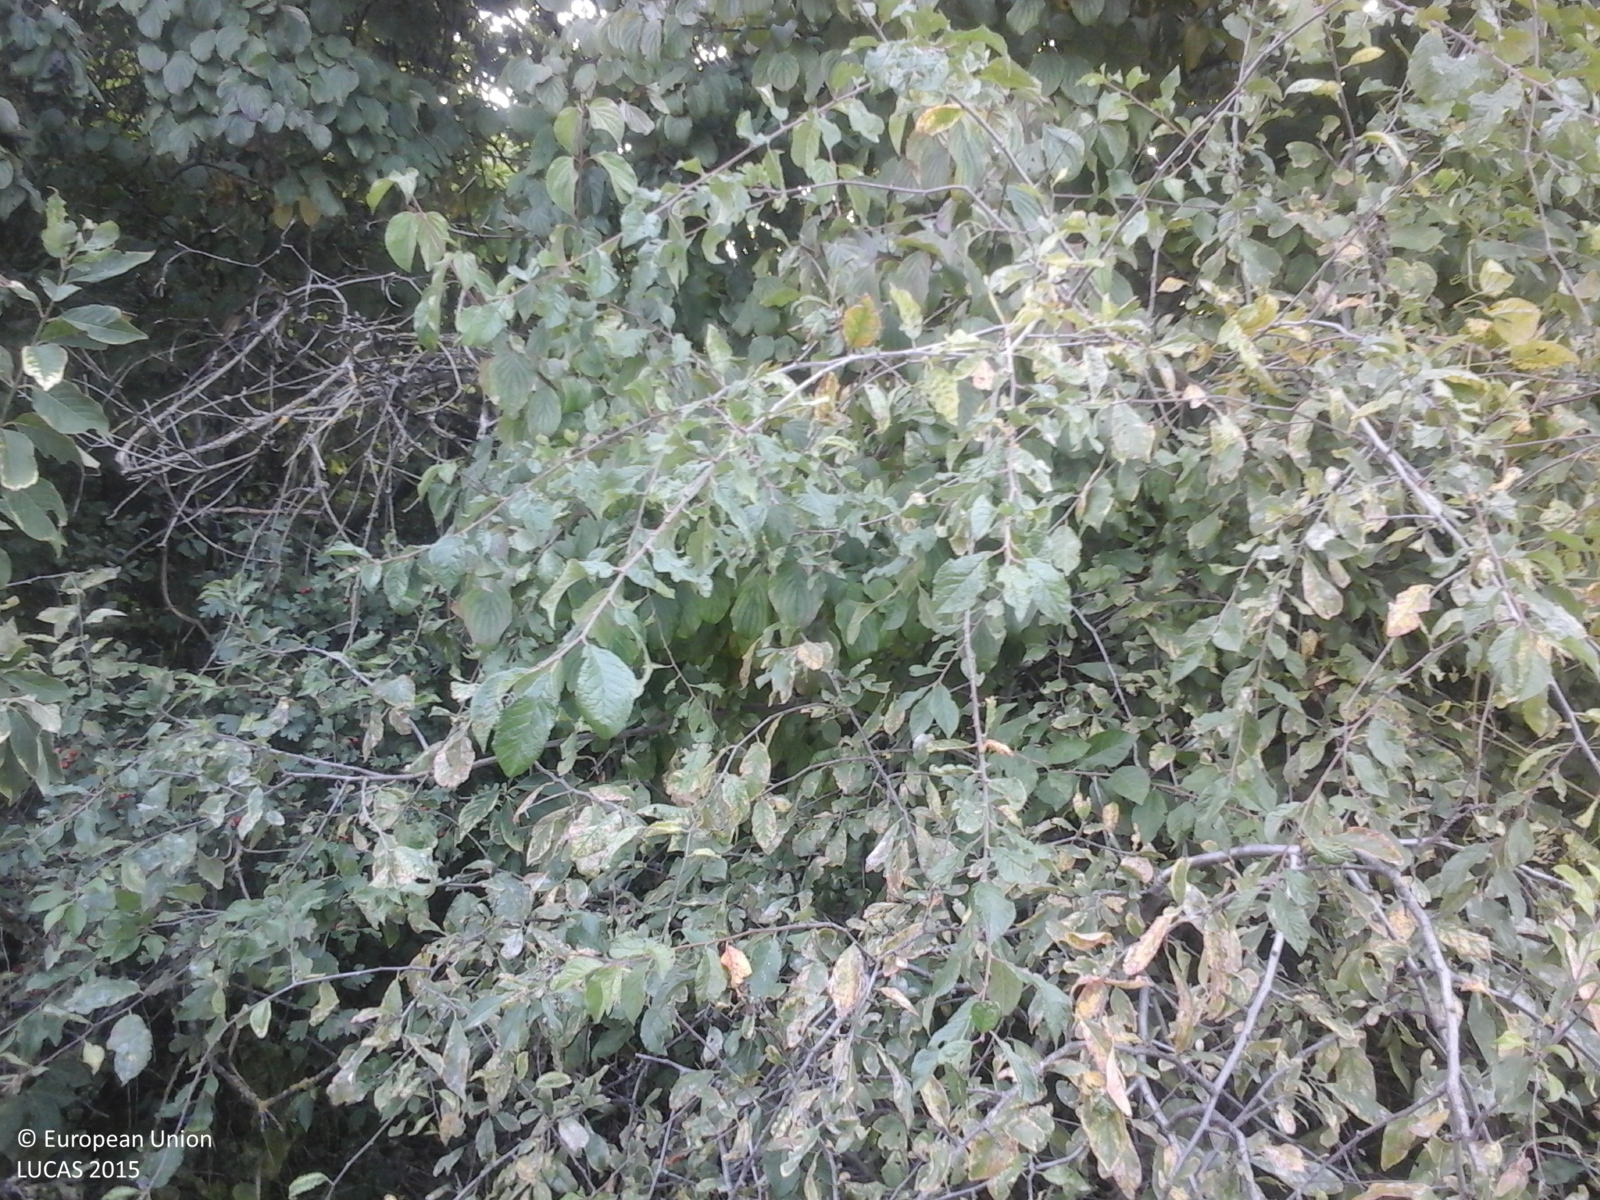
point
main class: Woodland
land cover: Broadleaved woodland
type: acidophilous oak and oak-birch forest
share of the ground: > 75 %
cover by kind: broadleaved forest trees 100 %
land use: Forestry
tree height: > 5 m
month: September
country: RO
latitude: 46.8052
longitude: 24.0617
